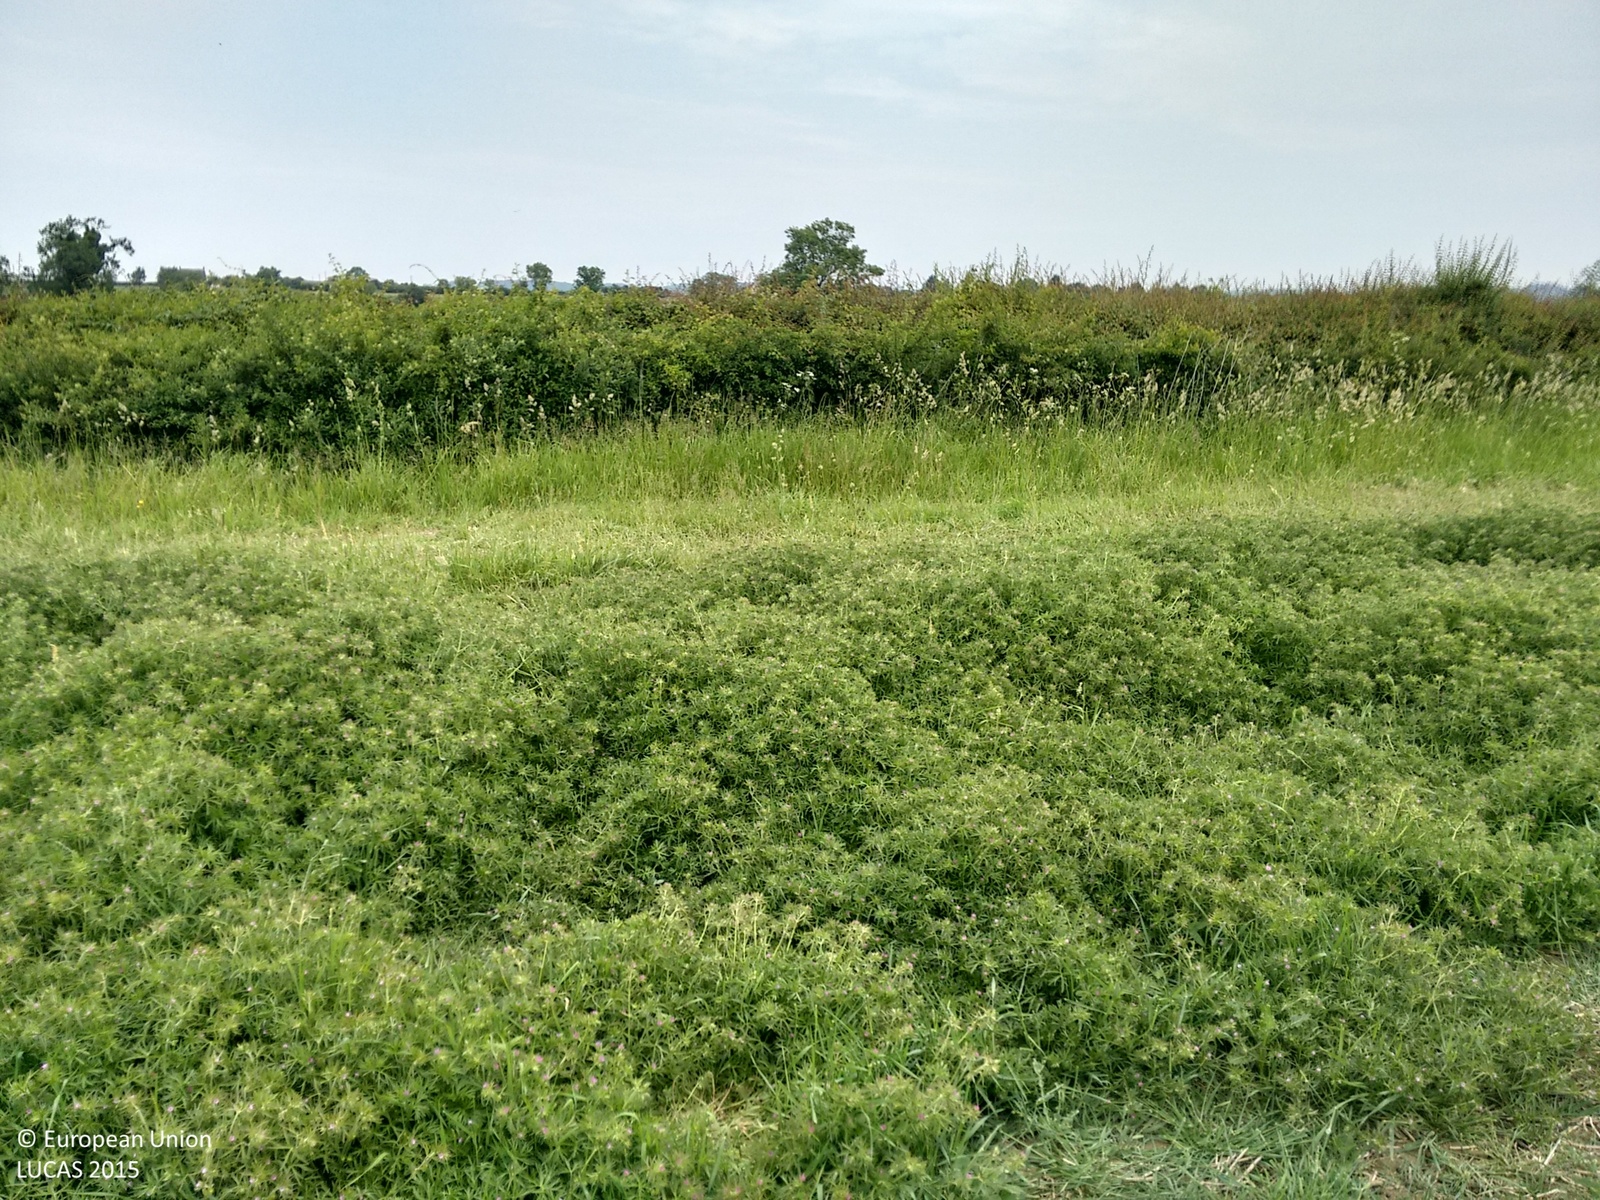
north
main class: Cropland
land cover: Rape and turnip rape
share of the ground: > 75 %
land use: Agriculture (excluding fallow land and kitchen gardens)
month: June
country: GB
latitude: 52.0916
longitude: -1.6569
